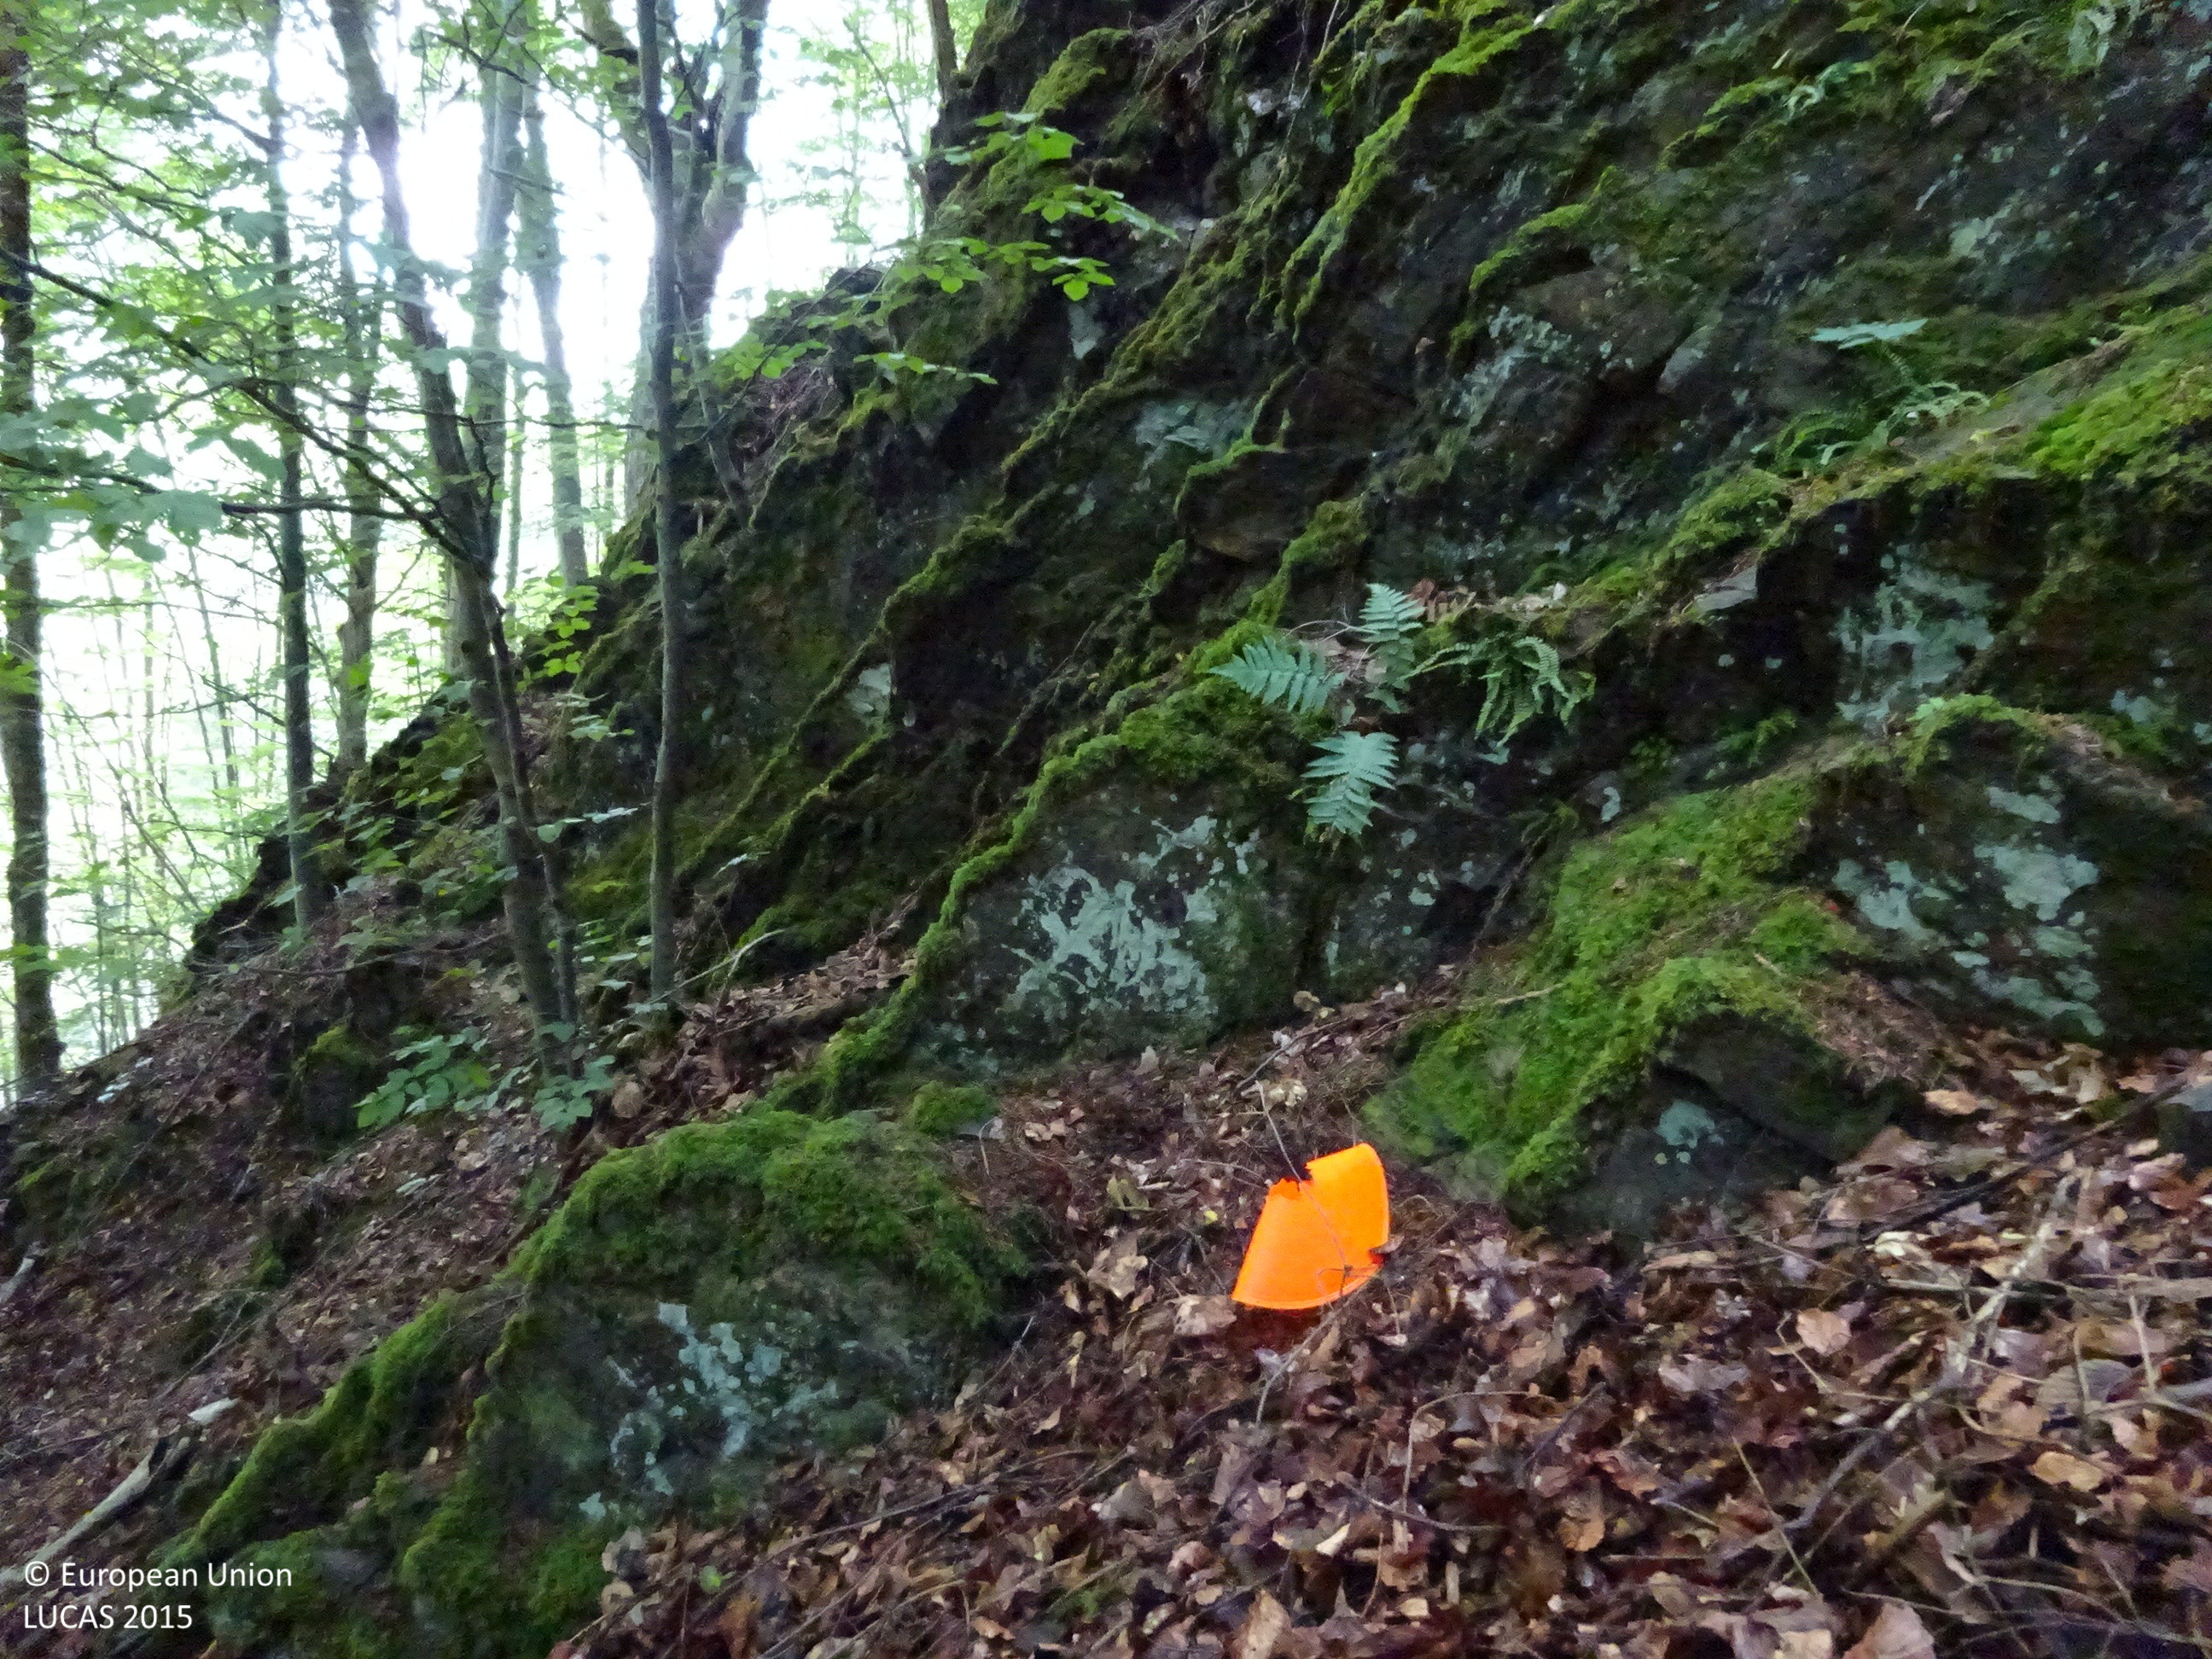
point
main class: Woodland
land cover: Spruce dominated mixed woodland
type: mountainous beech forest
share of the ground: > 75 %
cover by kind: broadleaved forest trees 70 %, coniferous forest trees 25 %, consolidated bare surface 5 %
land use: Forestry
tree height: > 5 m
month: July
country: AT
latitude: 47.3702
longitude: 15.3902
